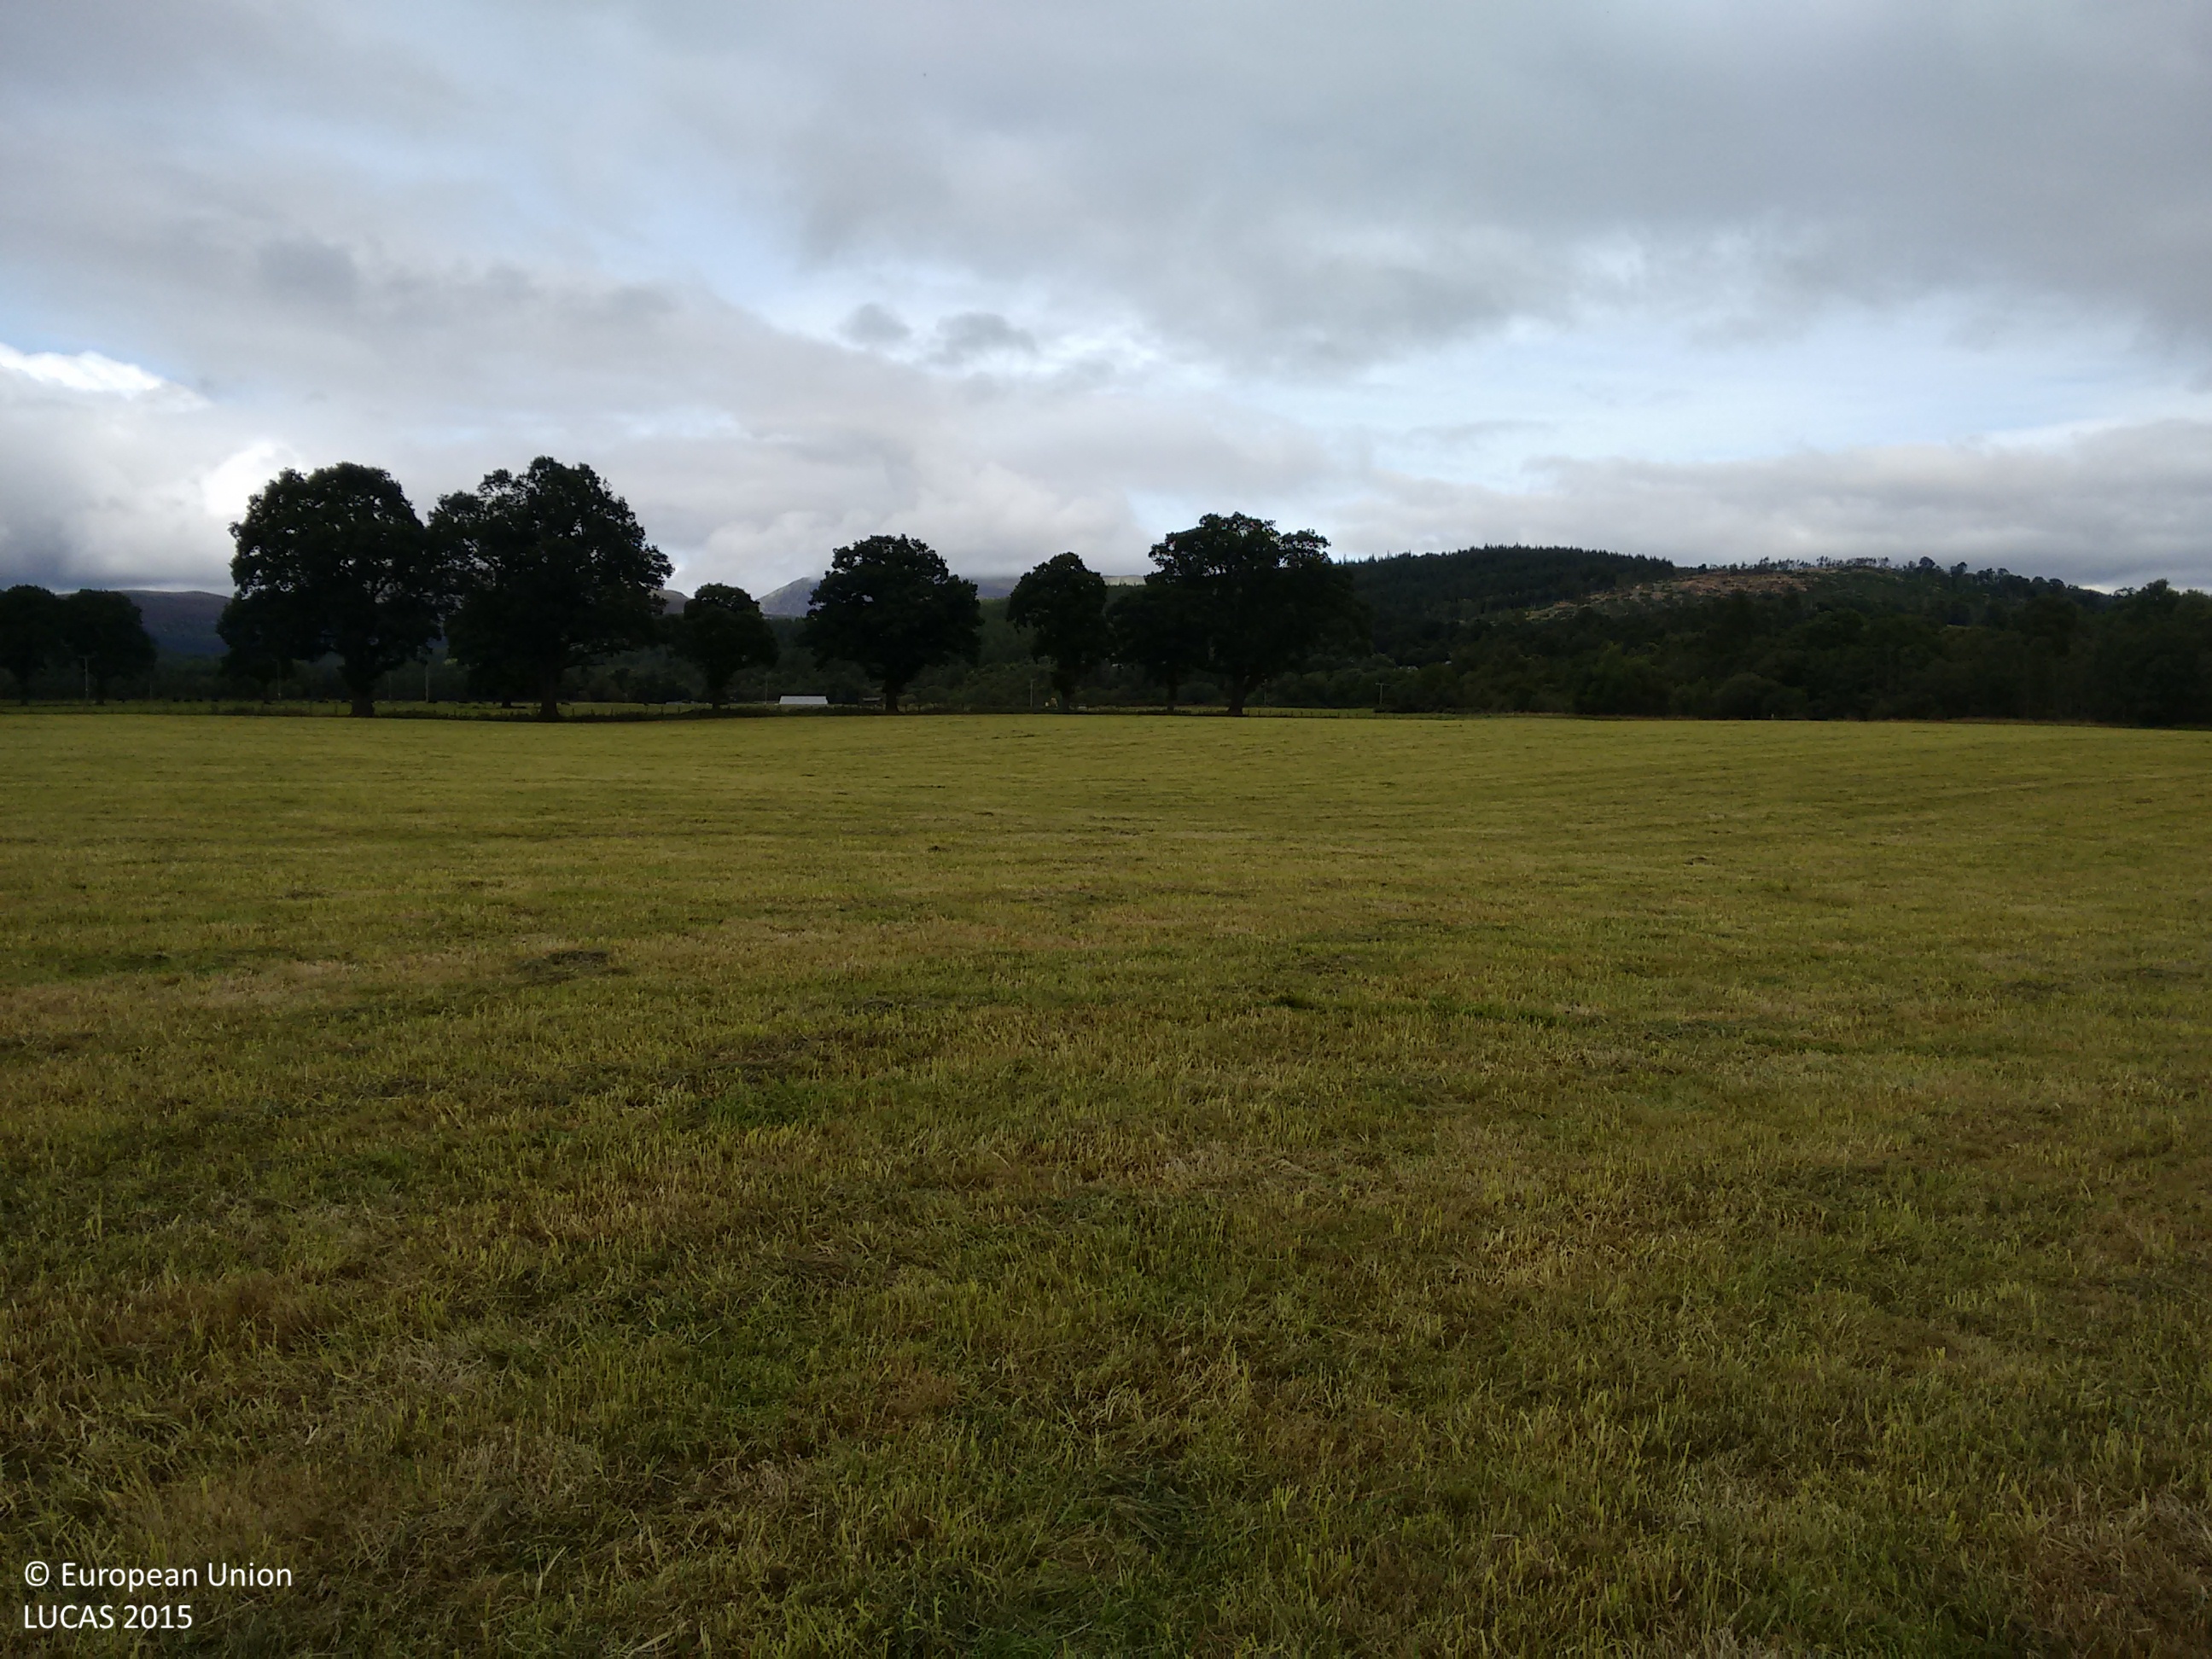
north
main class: Grassland
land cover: Grassland without tree/shrub cover
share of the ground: > 75 %
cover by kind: herbaceous plants 100 %
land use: Agriculture (excluding fallow land and kitchen gardens)
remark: Harvested field
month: September
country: GB
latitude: 57.5641
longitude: -4.5859
